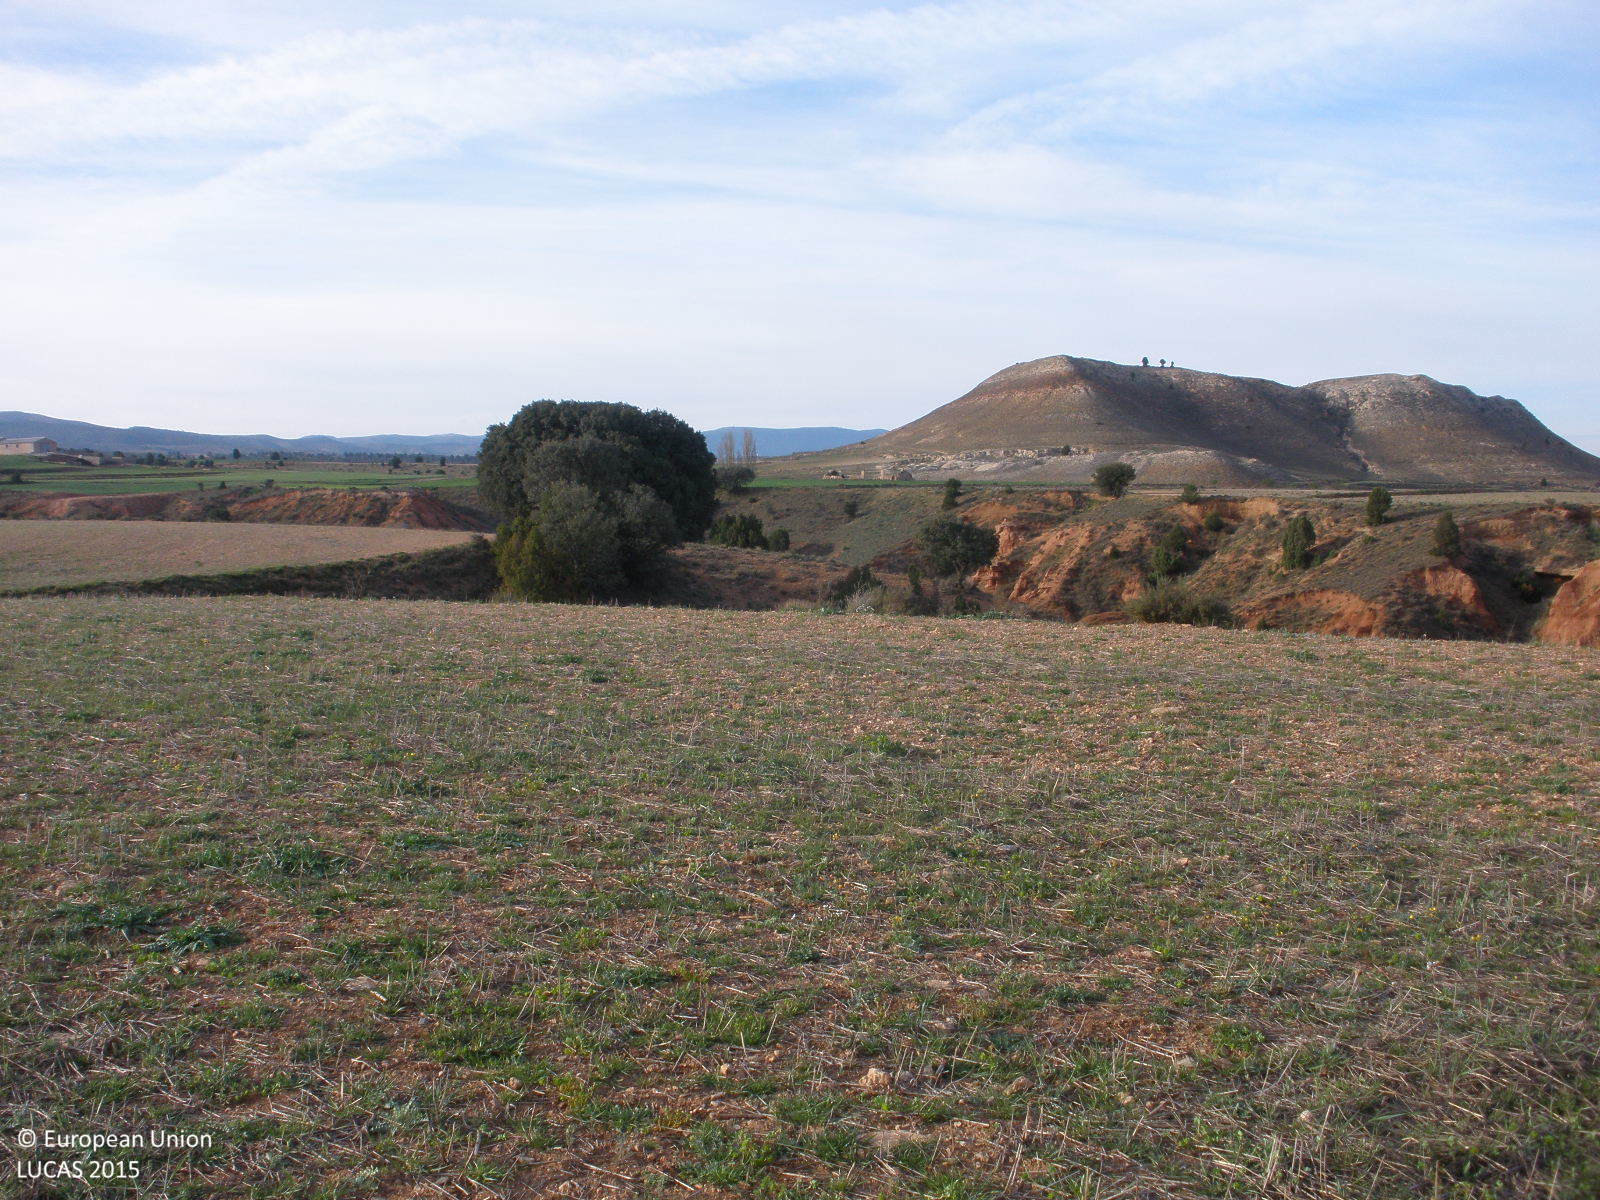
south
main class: Grassland
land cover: Spontaneously vegetated surfaces
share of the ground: > 75 %
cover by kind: herbaceous plants 85 %, unconsolidated bare surface 15 %
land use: Agriculture (excluding fallow land and kitchen gardens)
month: April
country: ES
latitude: 40.3150
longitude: -1.0597
